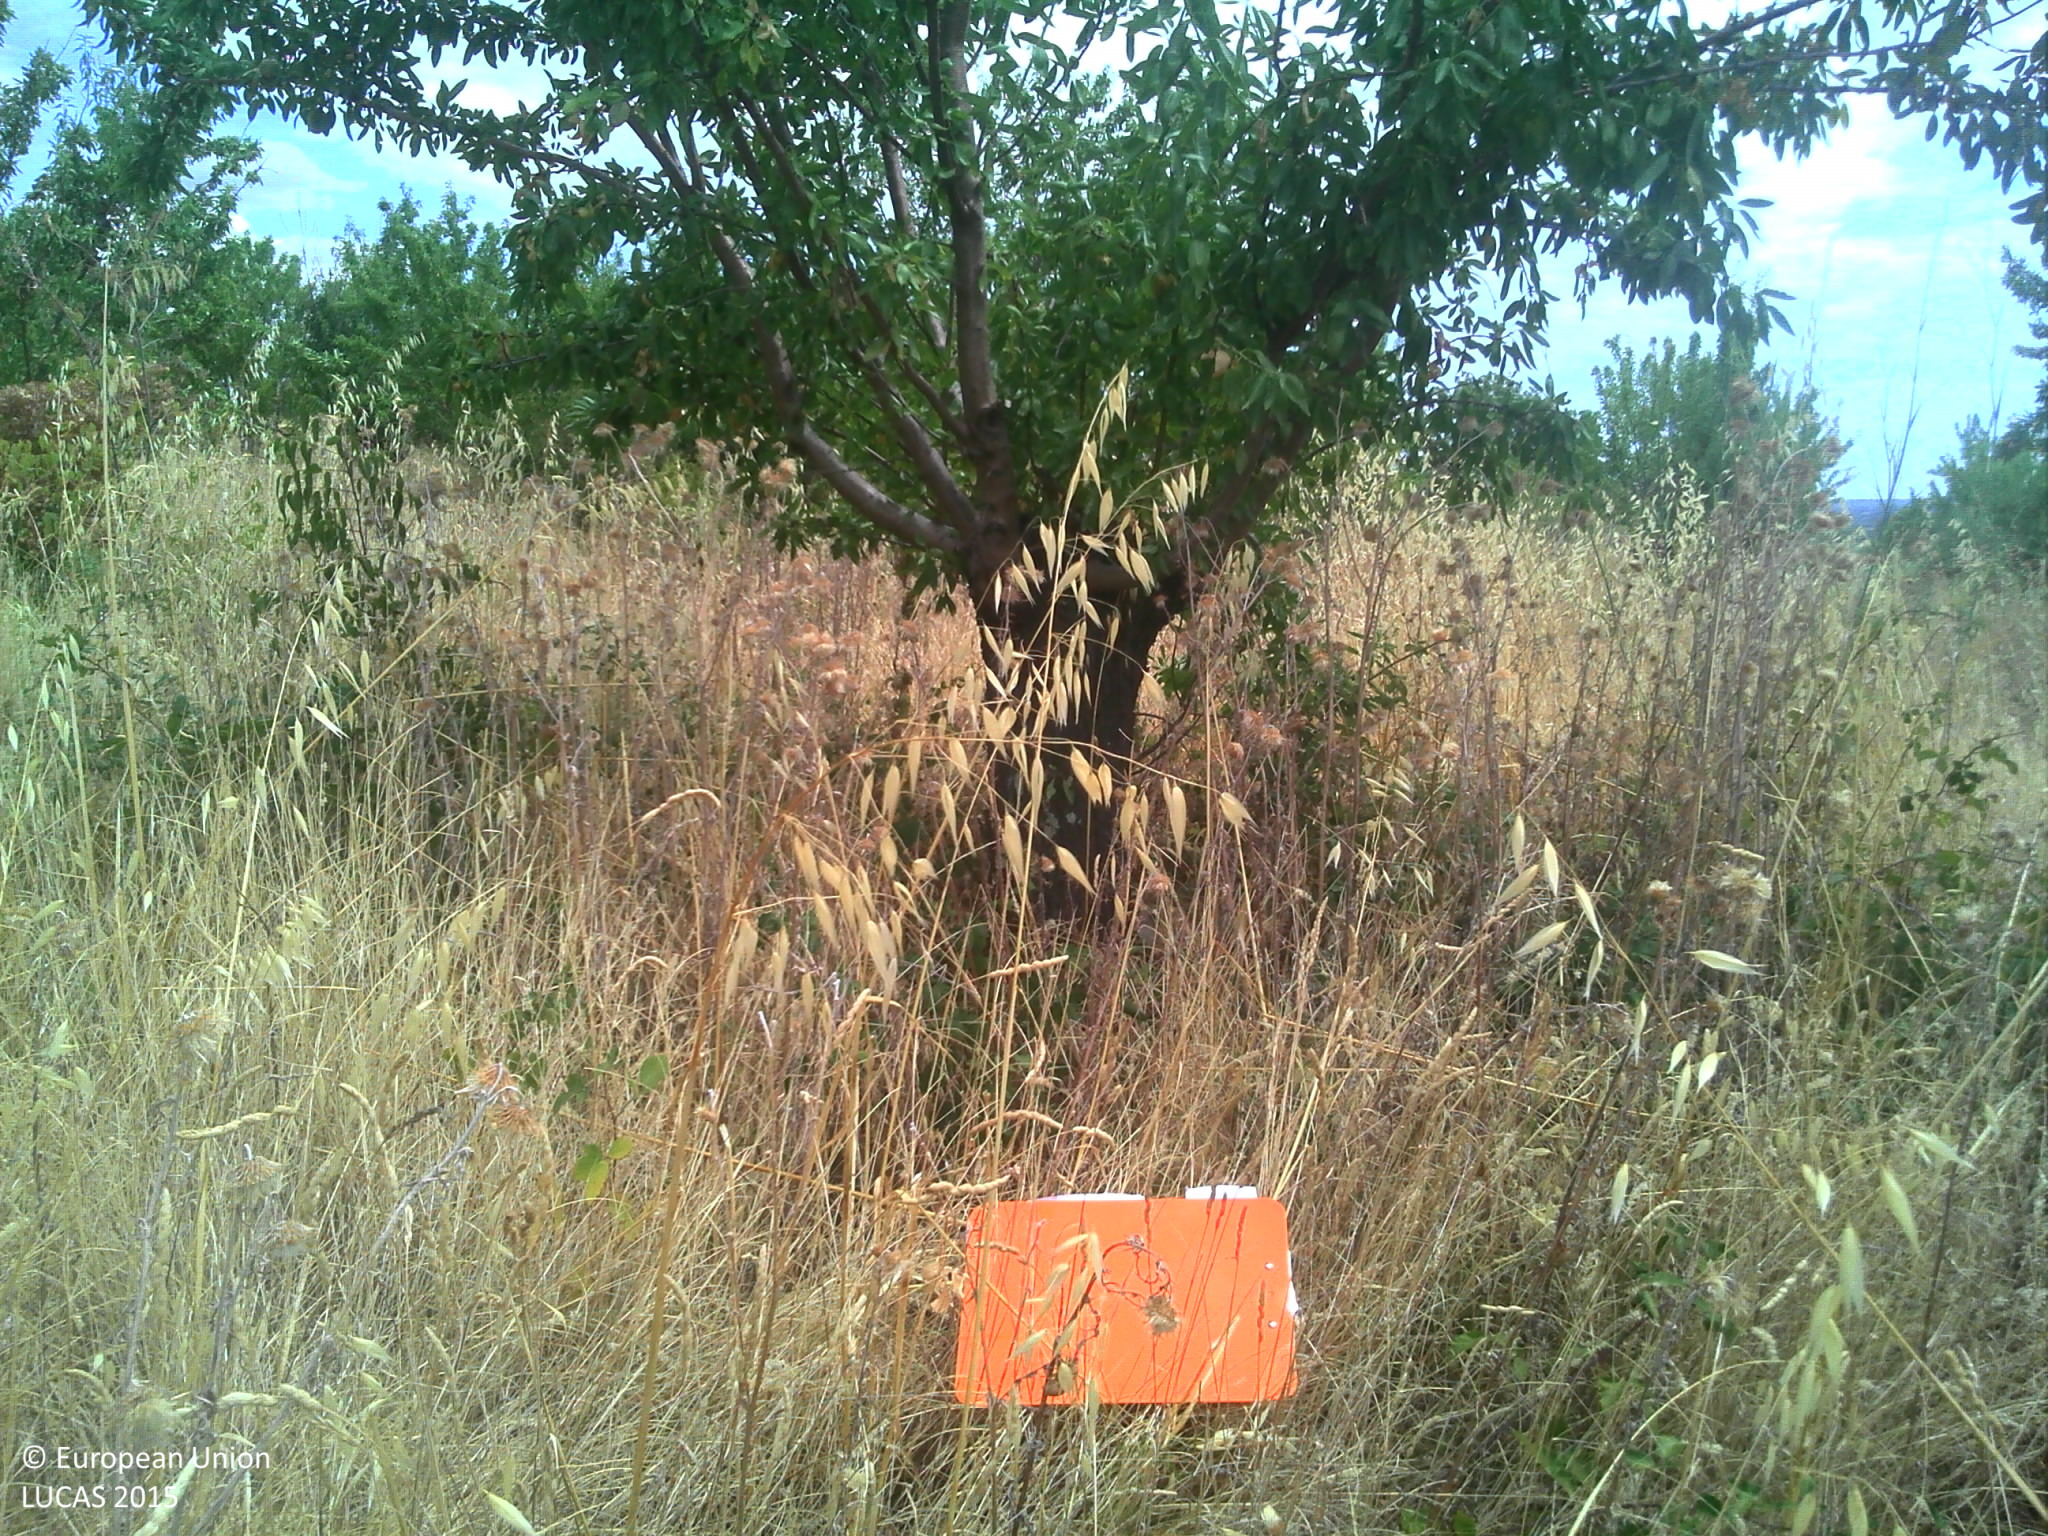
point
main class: Cropland
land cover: Nuts trees
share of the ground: 25 - 50 %
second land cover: Spontaneously vegetated surfaces
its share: > 75 %
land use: Agriculture (excluding fallow land and kitchen gardens)
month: July
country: FR
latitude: 43.4527
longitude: 3.1254
